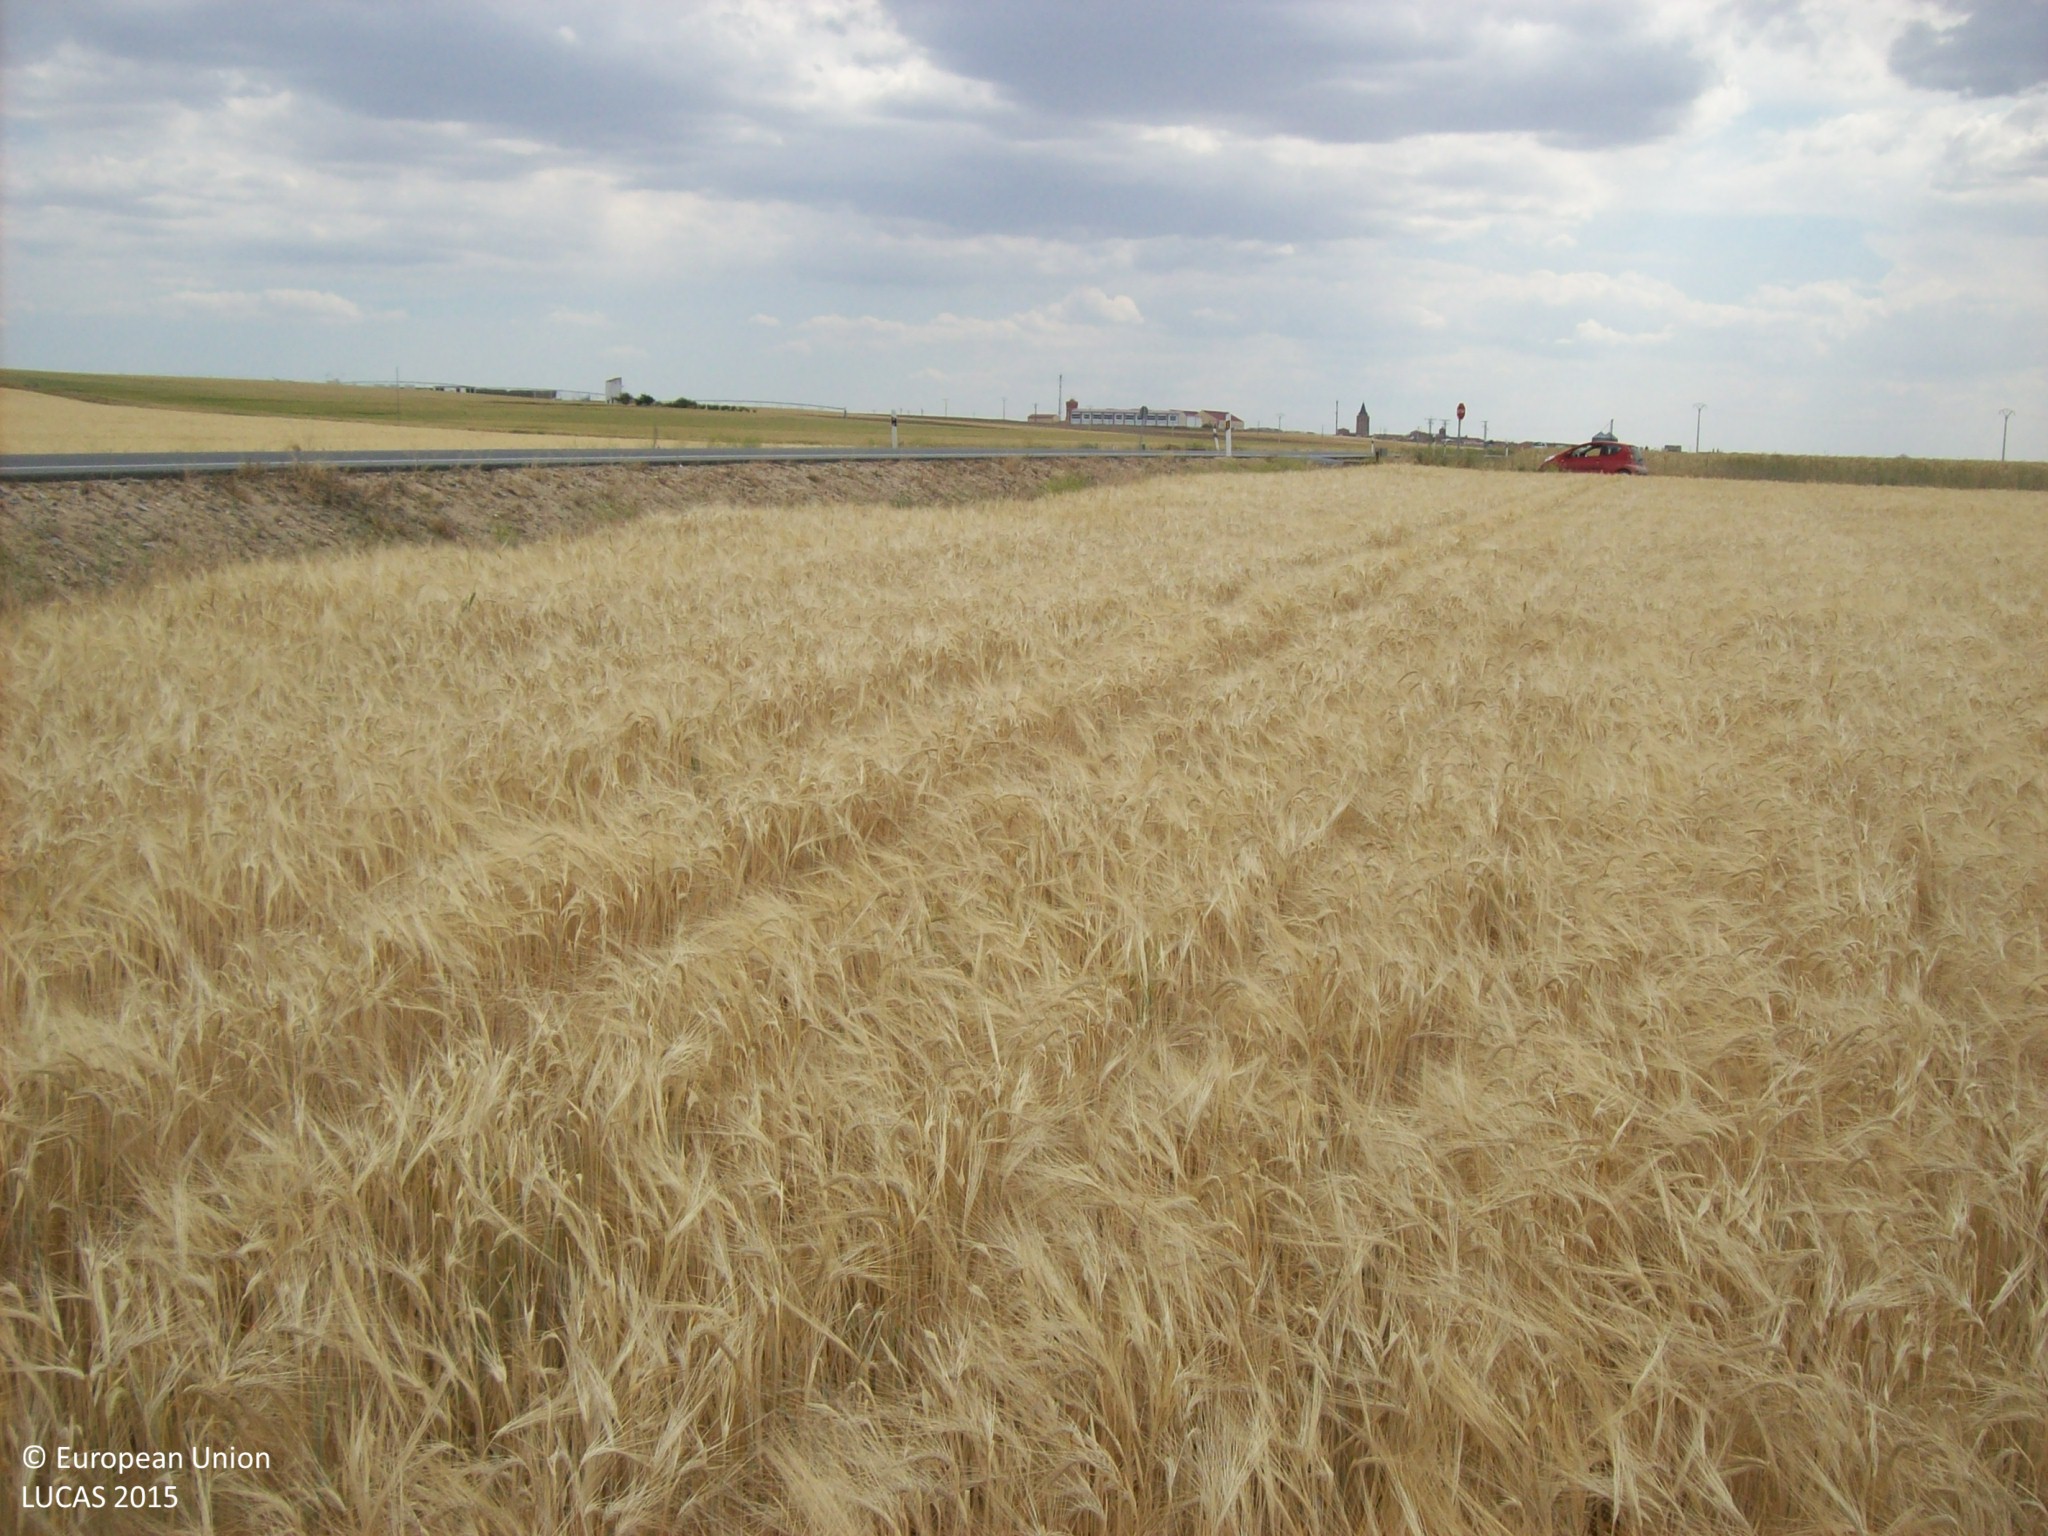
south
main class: Cropland
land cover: Barley
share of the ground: > 75 %
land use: Agriculture (excluding fallow land and kitchen gardens)
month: June
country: ES
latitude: 41.1097
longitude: -4.9877
